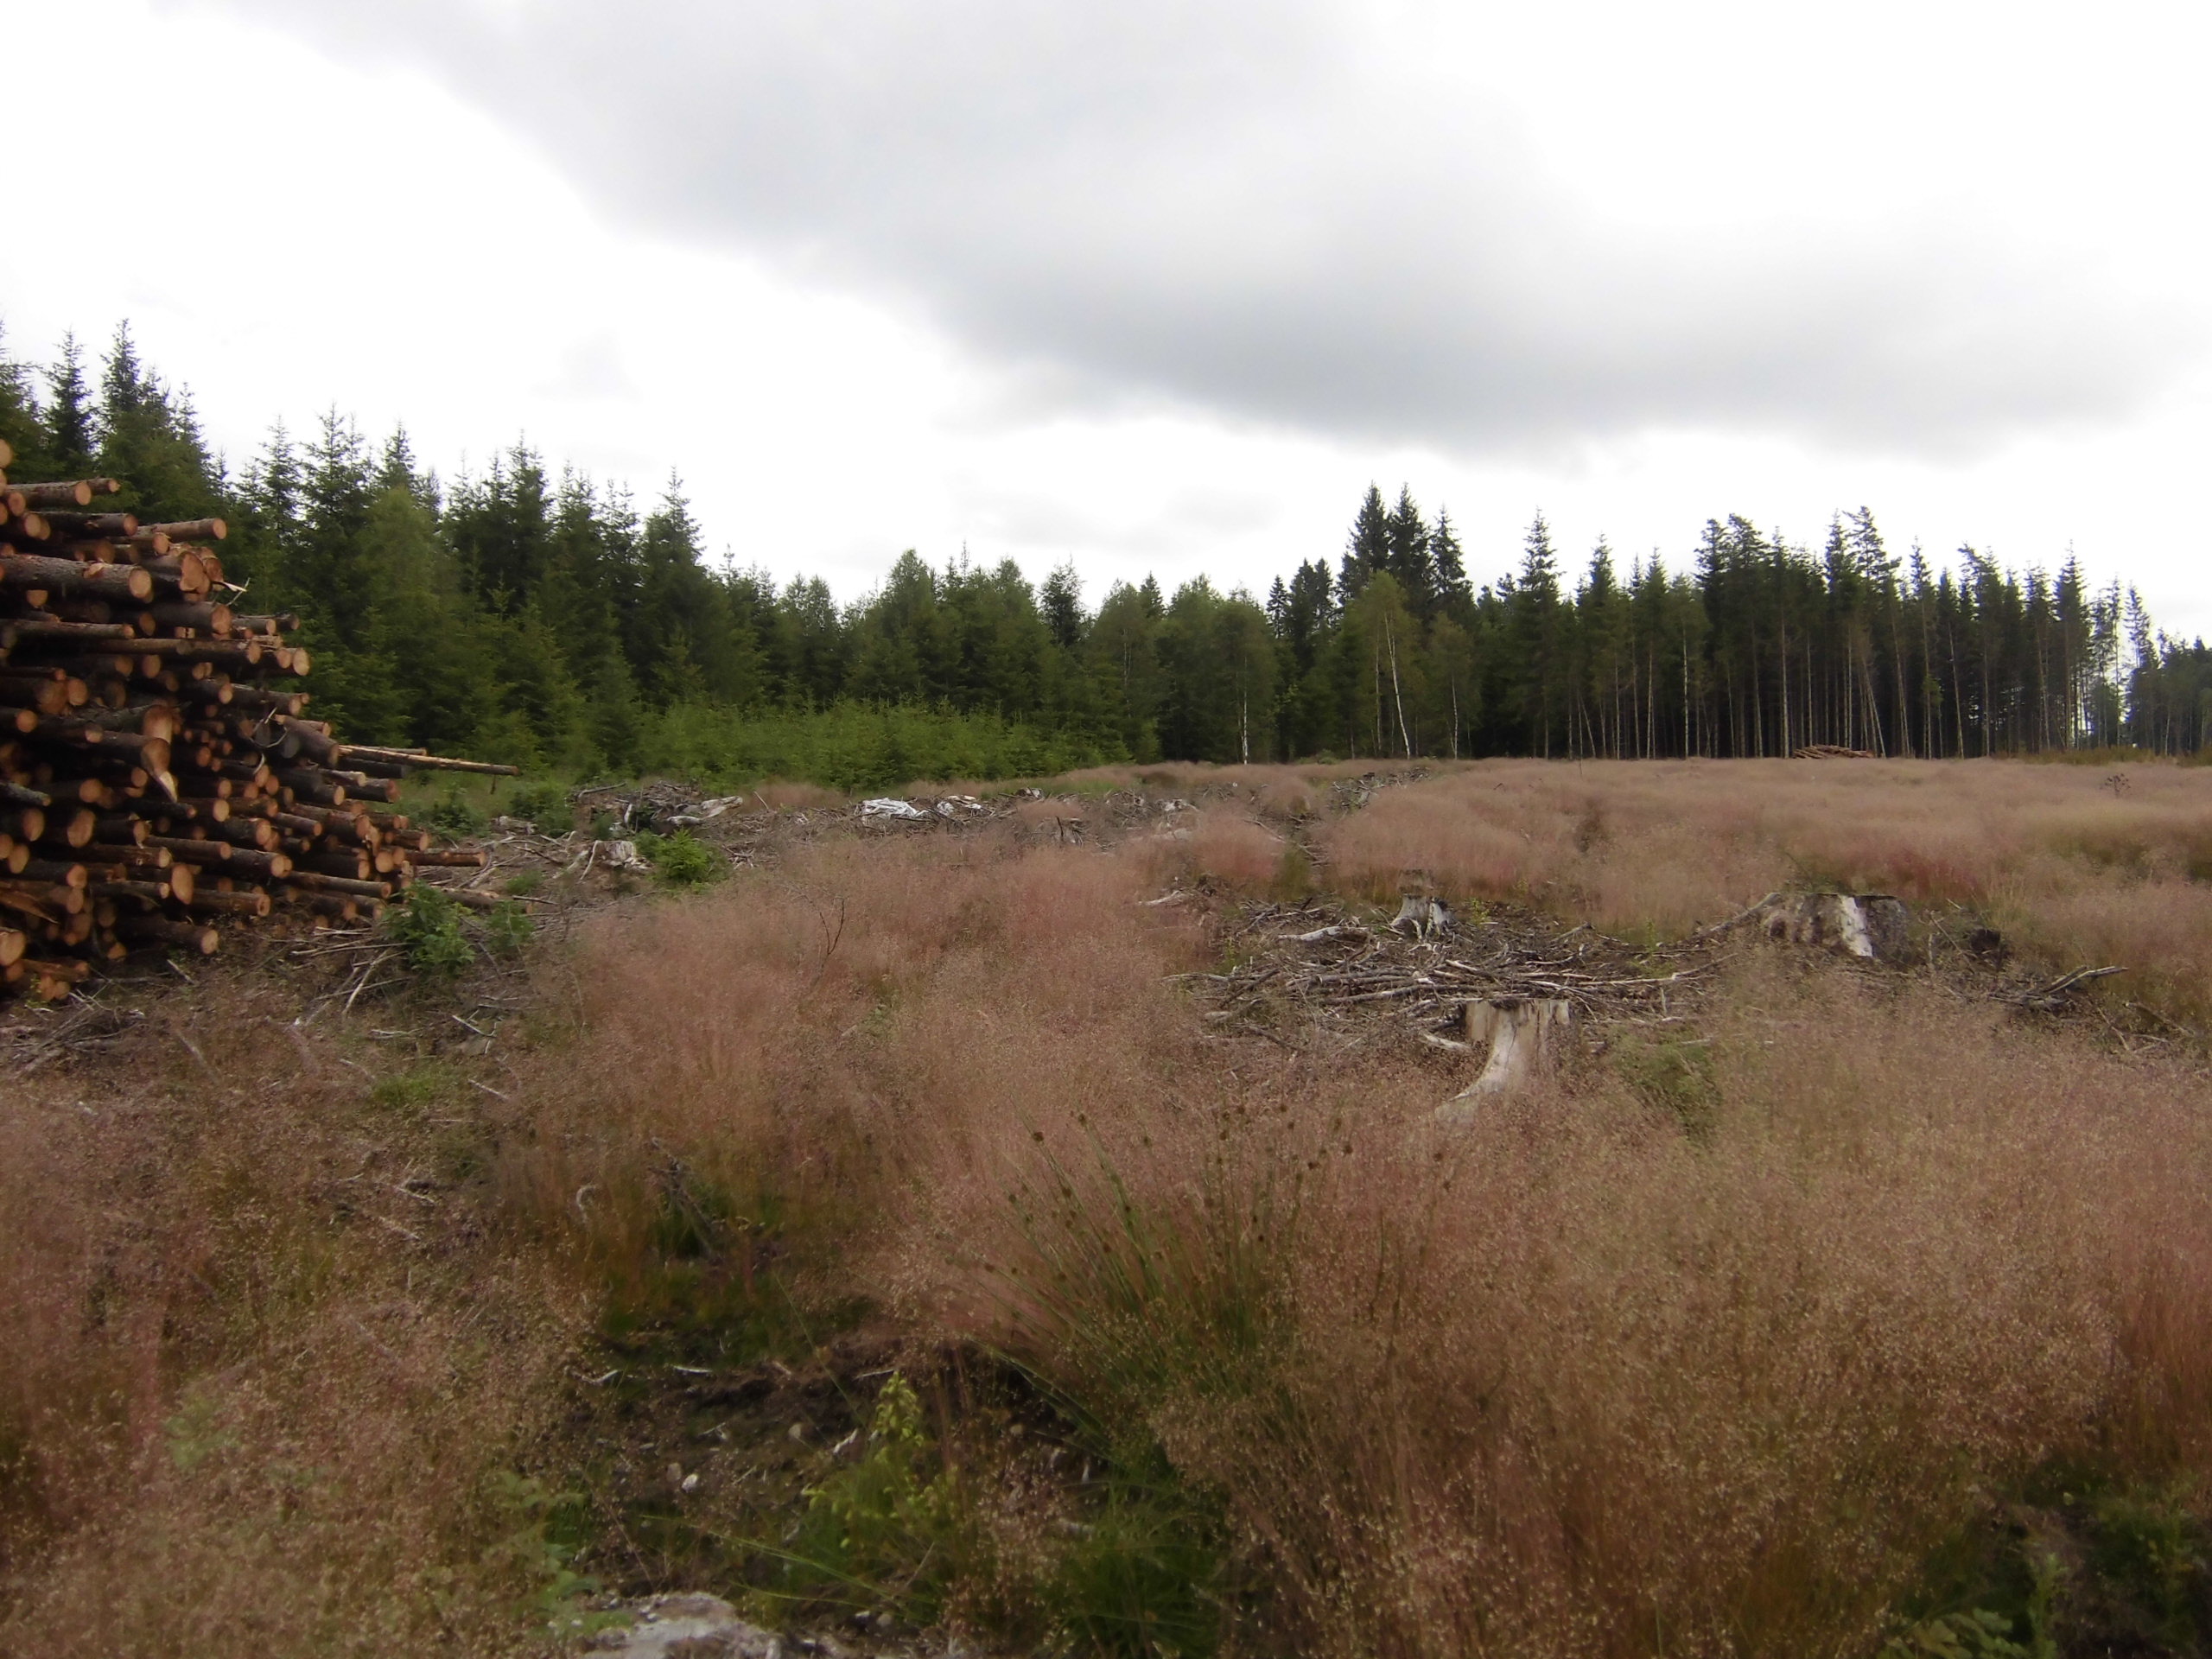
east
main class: Woodland
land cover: Spruce dominated mixed woodland
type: boreal forest
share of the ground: 25 - 50 %
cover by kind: herbaceous plants 45 %, broadleaved forest trees 15 %, coniferous forest trees 10 %, shrubs 10 %, lichens and mosses 10 %, unconsolidated bare surface 10 %
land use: Forestry
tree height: < 5 m
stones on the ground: 10 - 25 %
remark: Clear cut
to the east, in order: Spruce dominated mixed woodland; Tracks; Spruce dominated coniferous woodland; Spruce dominated mixed woodland; Grassland with sparse tree/shrub cover
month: July
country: SE
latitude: 57.4666
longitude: 14.8142
